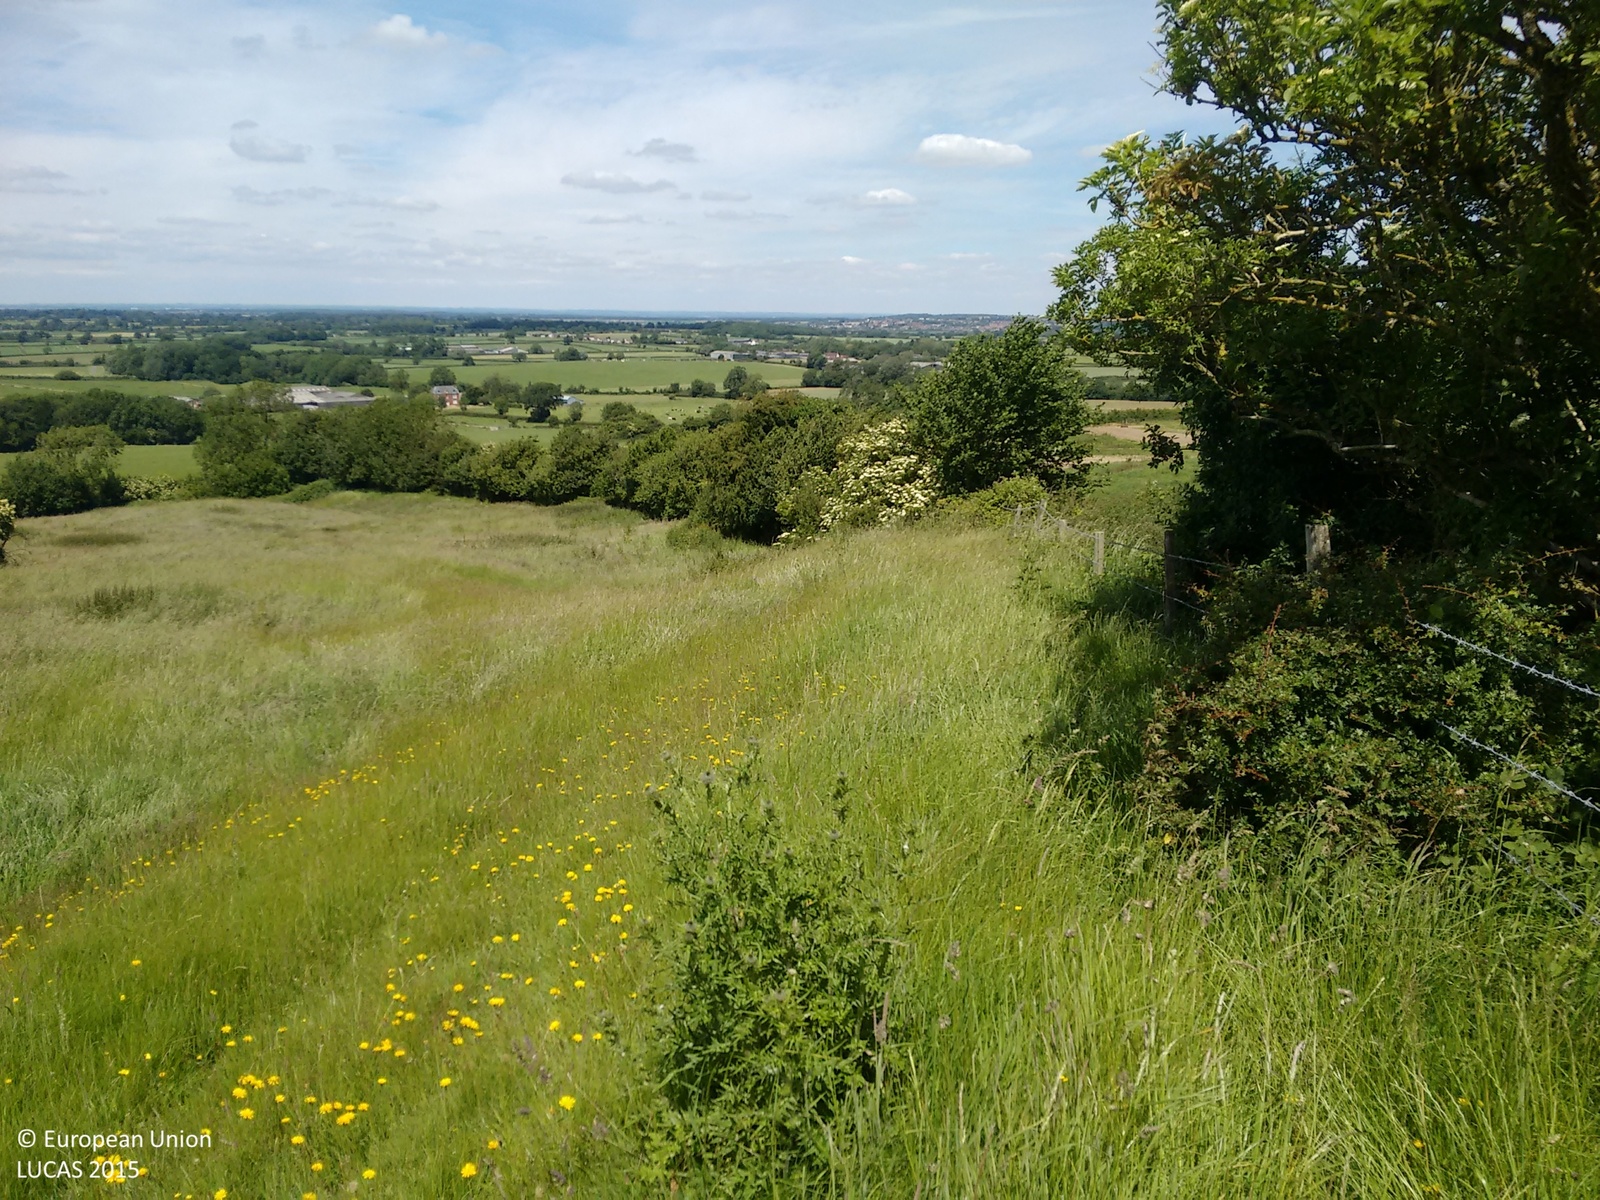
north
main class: Grassland
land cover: Grassland without tree/shrub cover
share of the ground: > 75 %
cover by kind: herbaceous plants 100 %
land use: Agriculture (excluding fallow land and kitchen gardens)
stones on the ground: < 10 %
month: June
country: GB
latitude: 51.4845
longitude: -1.9088
